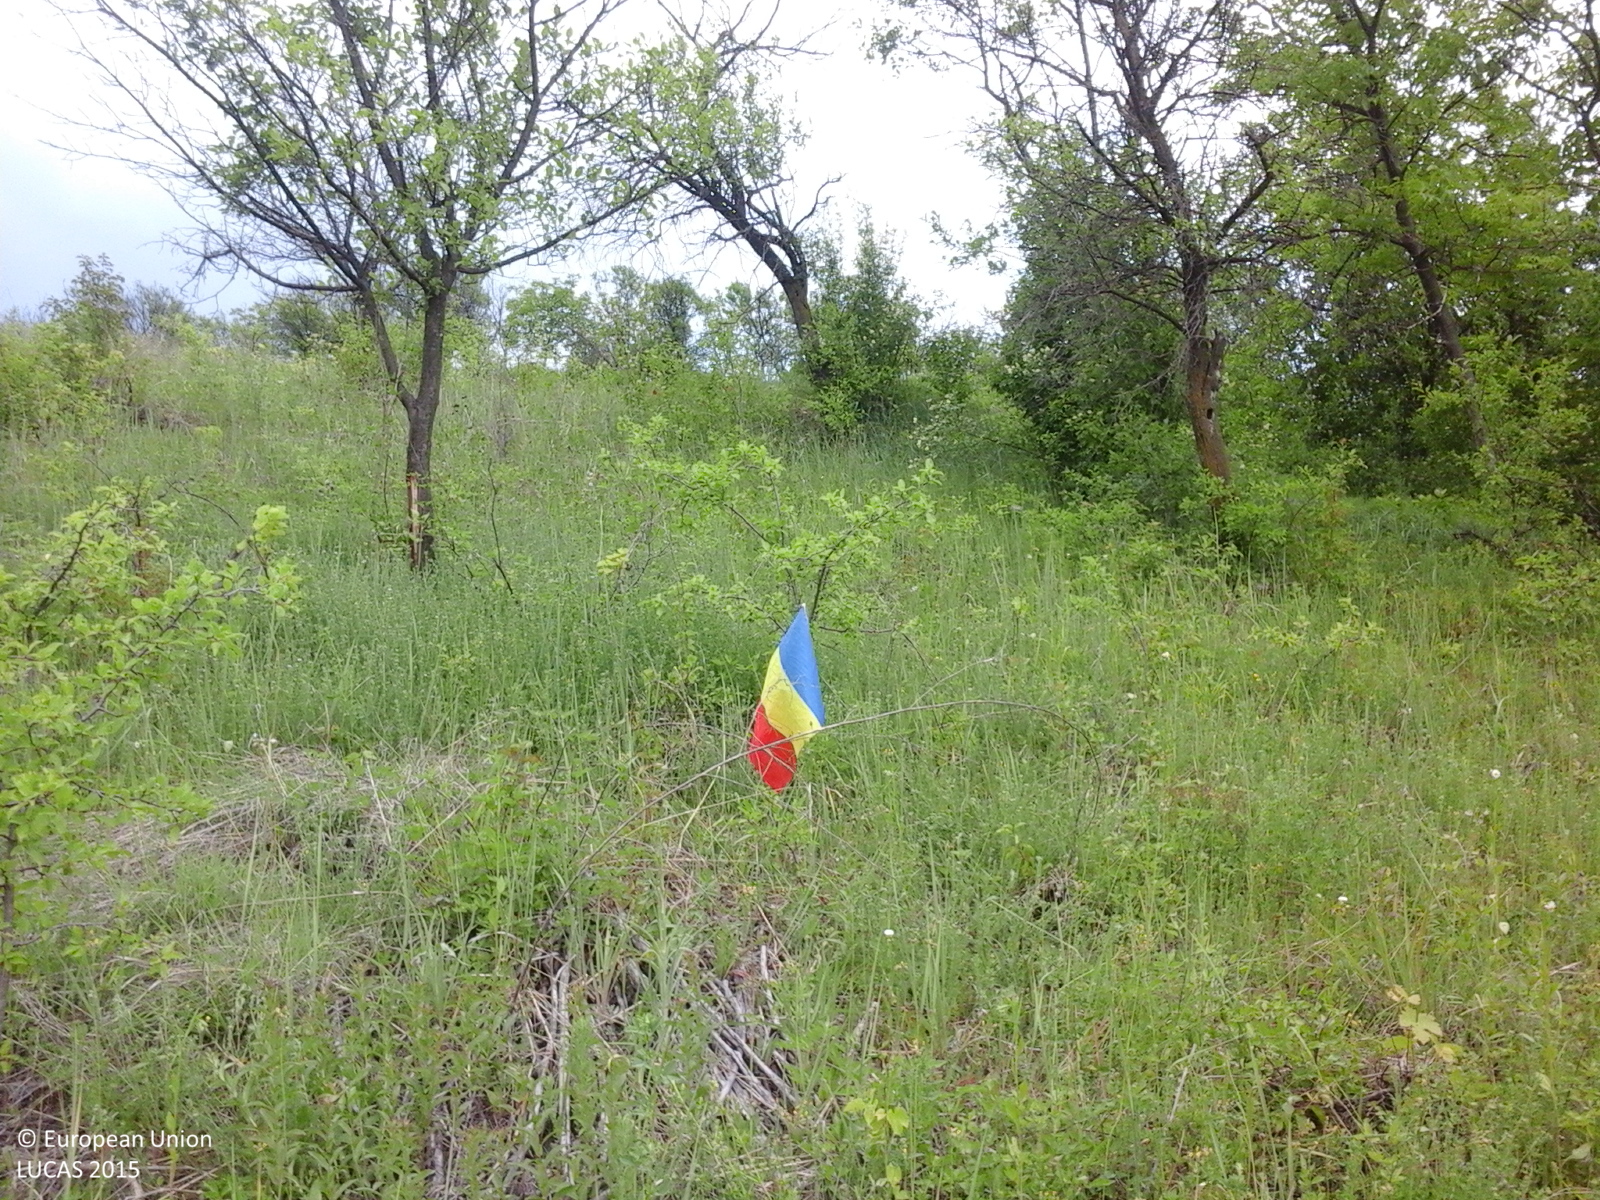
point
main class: Grassland
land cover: Grassland with sparse tree/shrub cover
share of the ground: > 75 %
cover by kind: herbaceous plants 90 %, broadleaved forest trees 5 %, shrubs 5 %
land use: Forestry
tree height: < 5 m
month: June
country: RO
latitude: 46.3540
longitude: 26.7881
